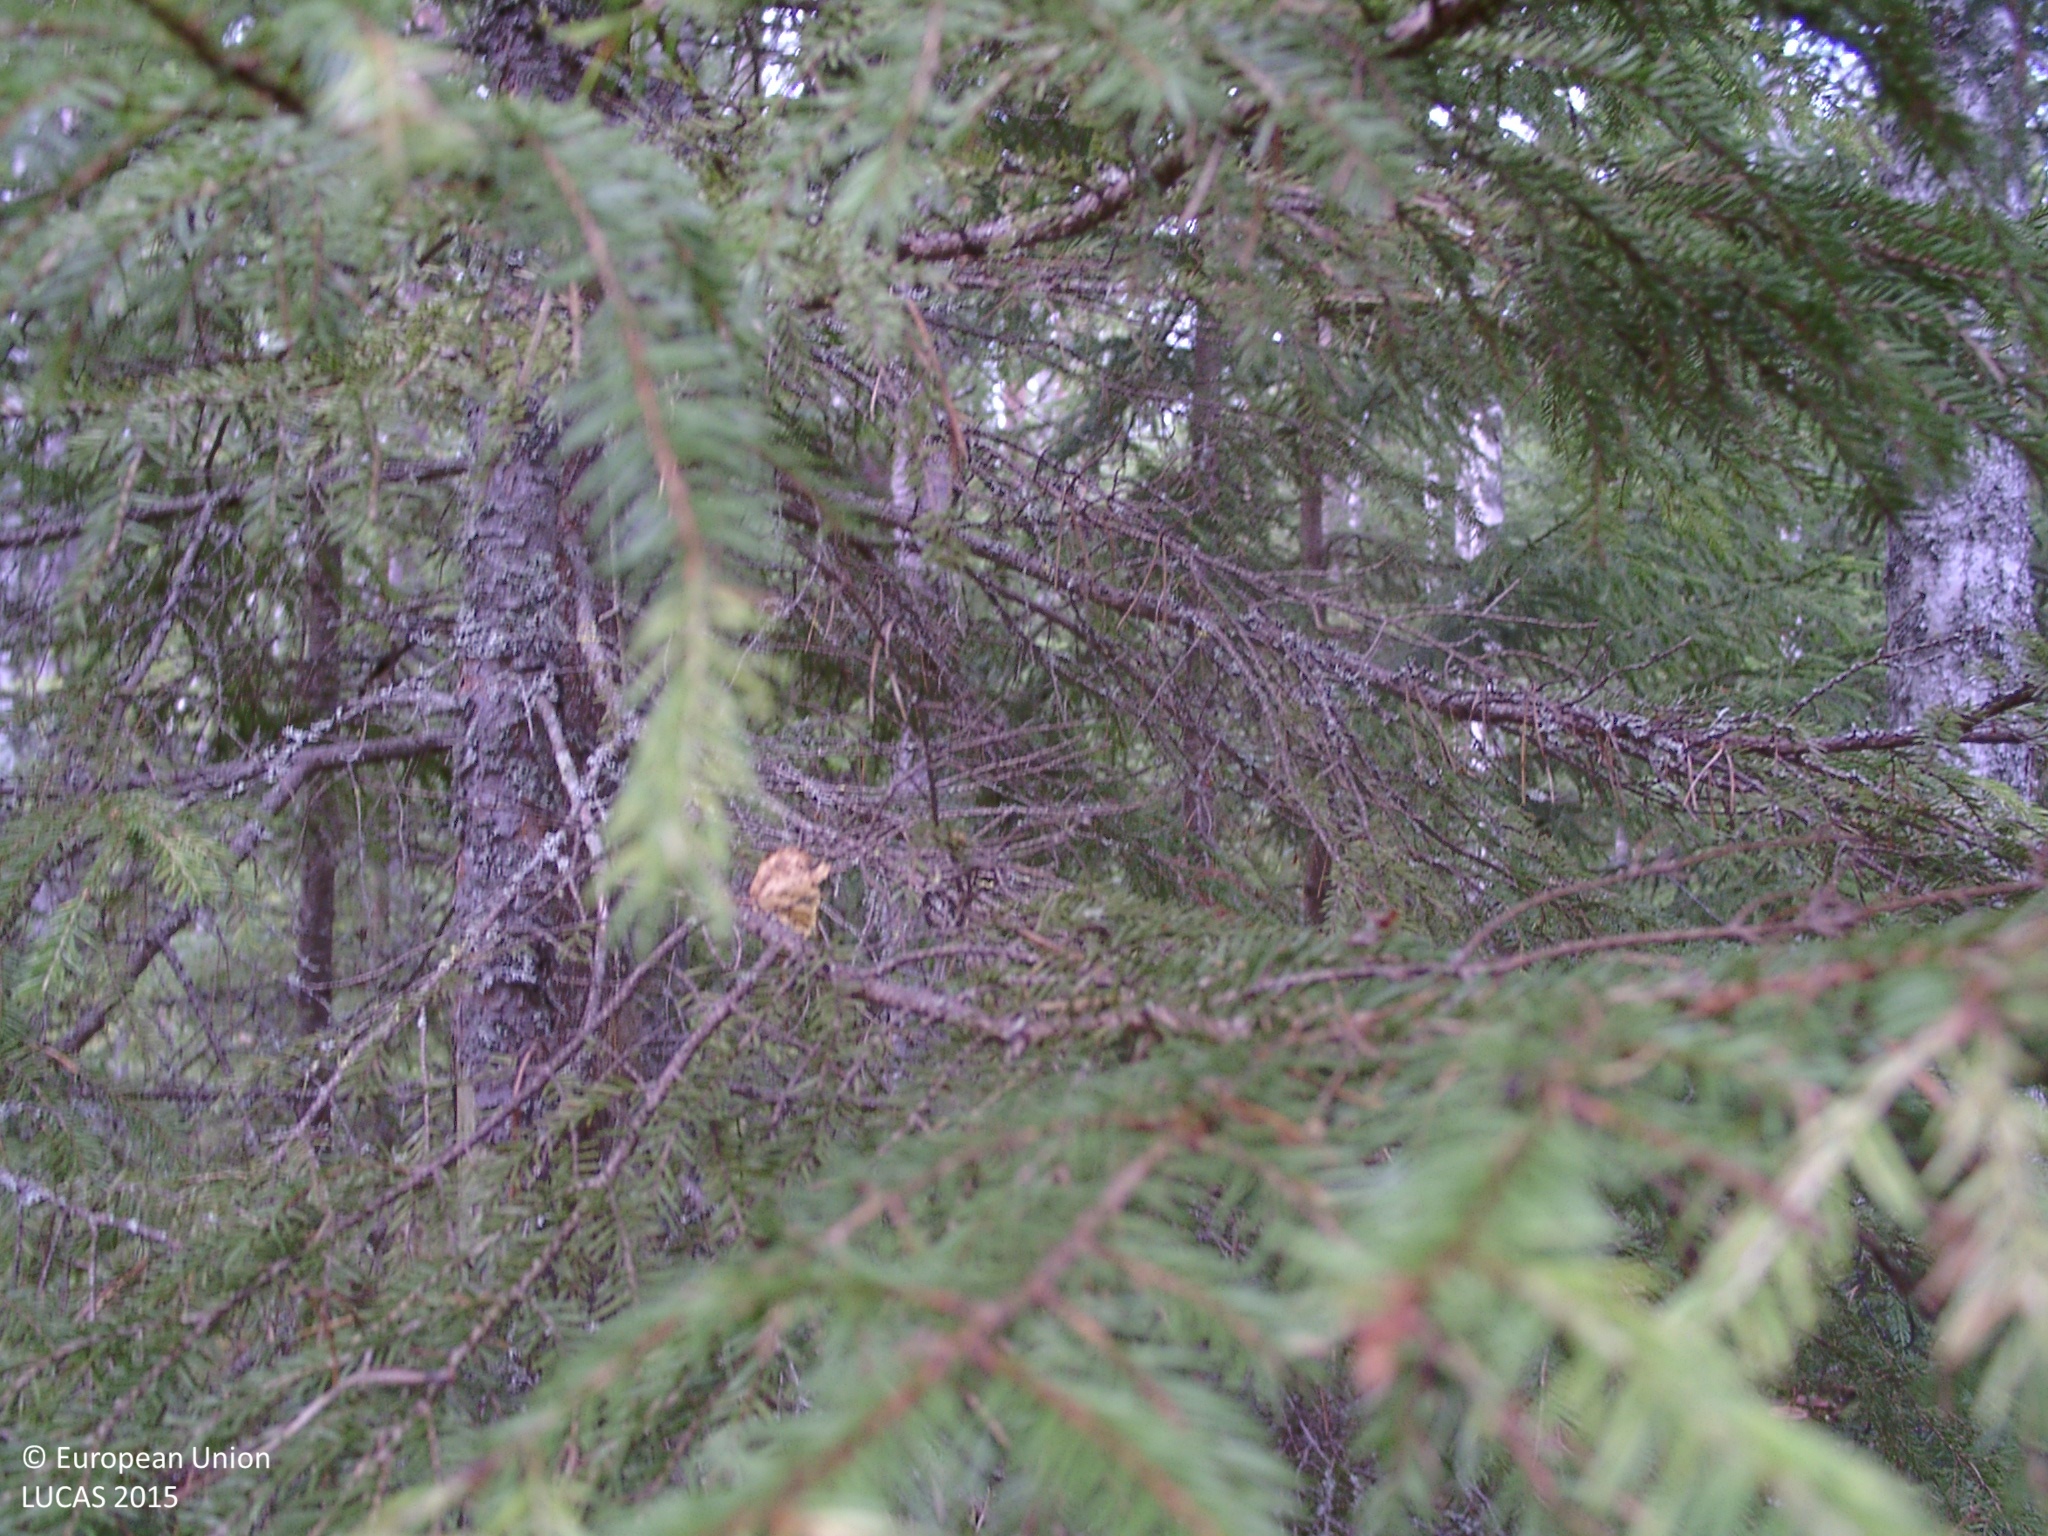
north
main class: Woodland
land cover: Other mixed woodland
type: boreal forest
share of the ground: > 75 %
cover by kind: coniferous forest trees 45 %, broadleaved forest trees 30 %, shrubs 20 %, lichens and mosses 5 %
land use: Forestry
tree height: > 5 m
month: August
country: FI
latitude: 63.0069
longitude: 25.0861
